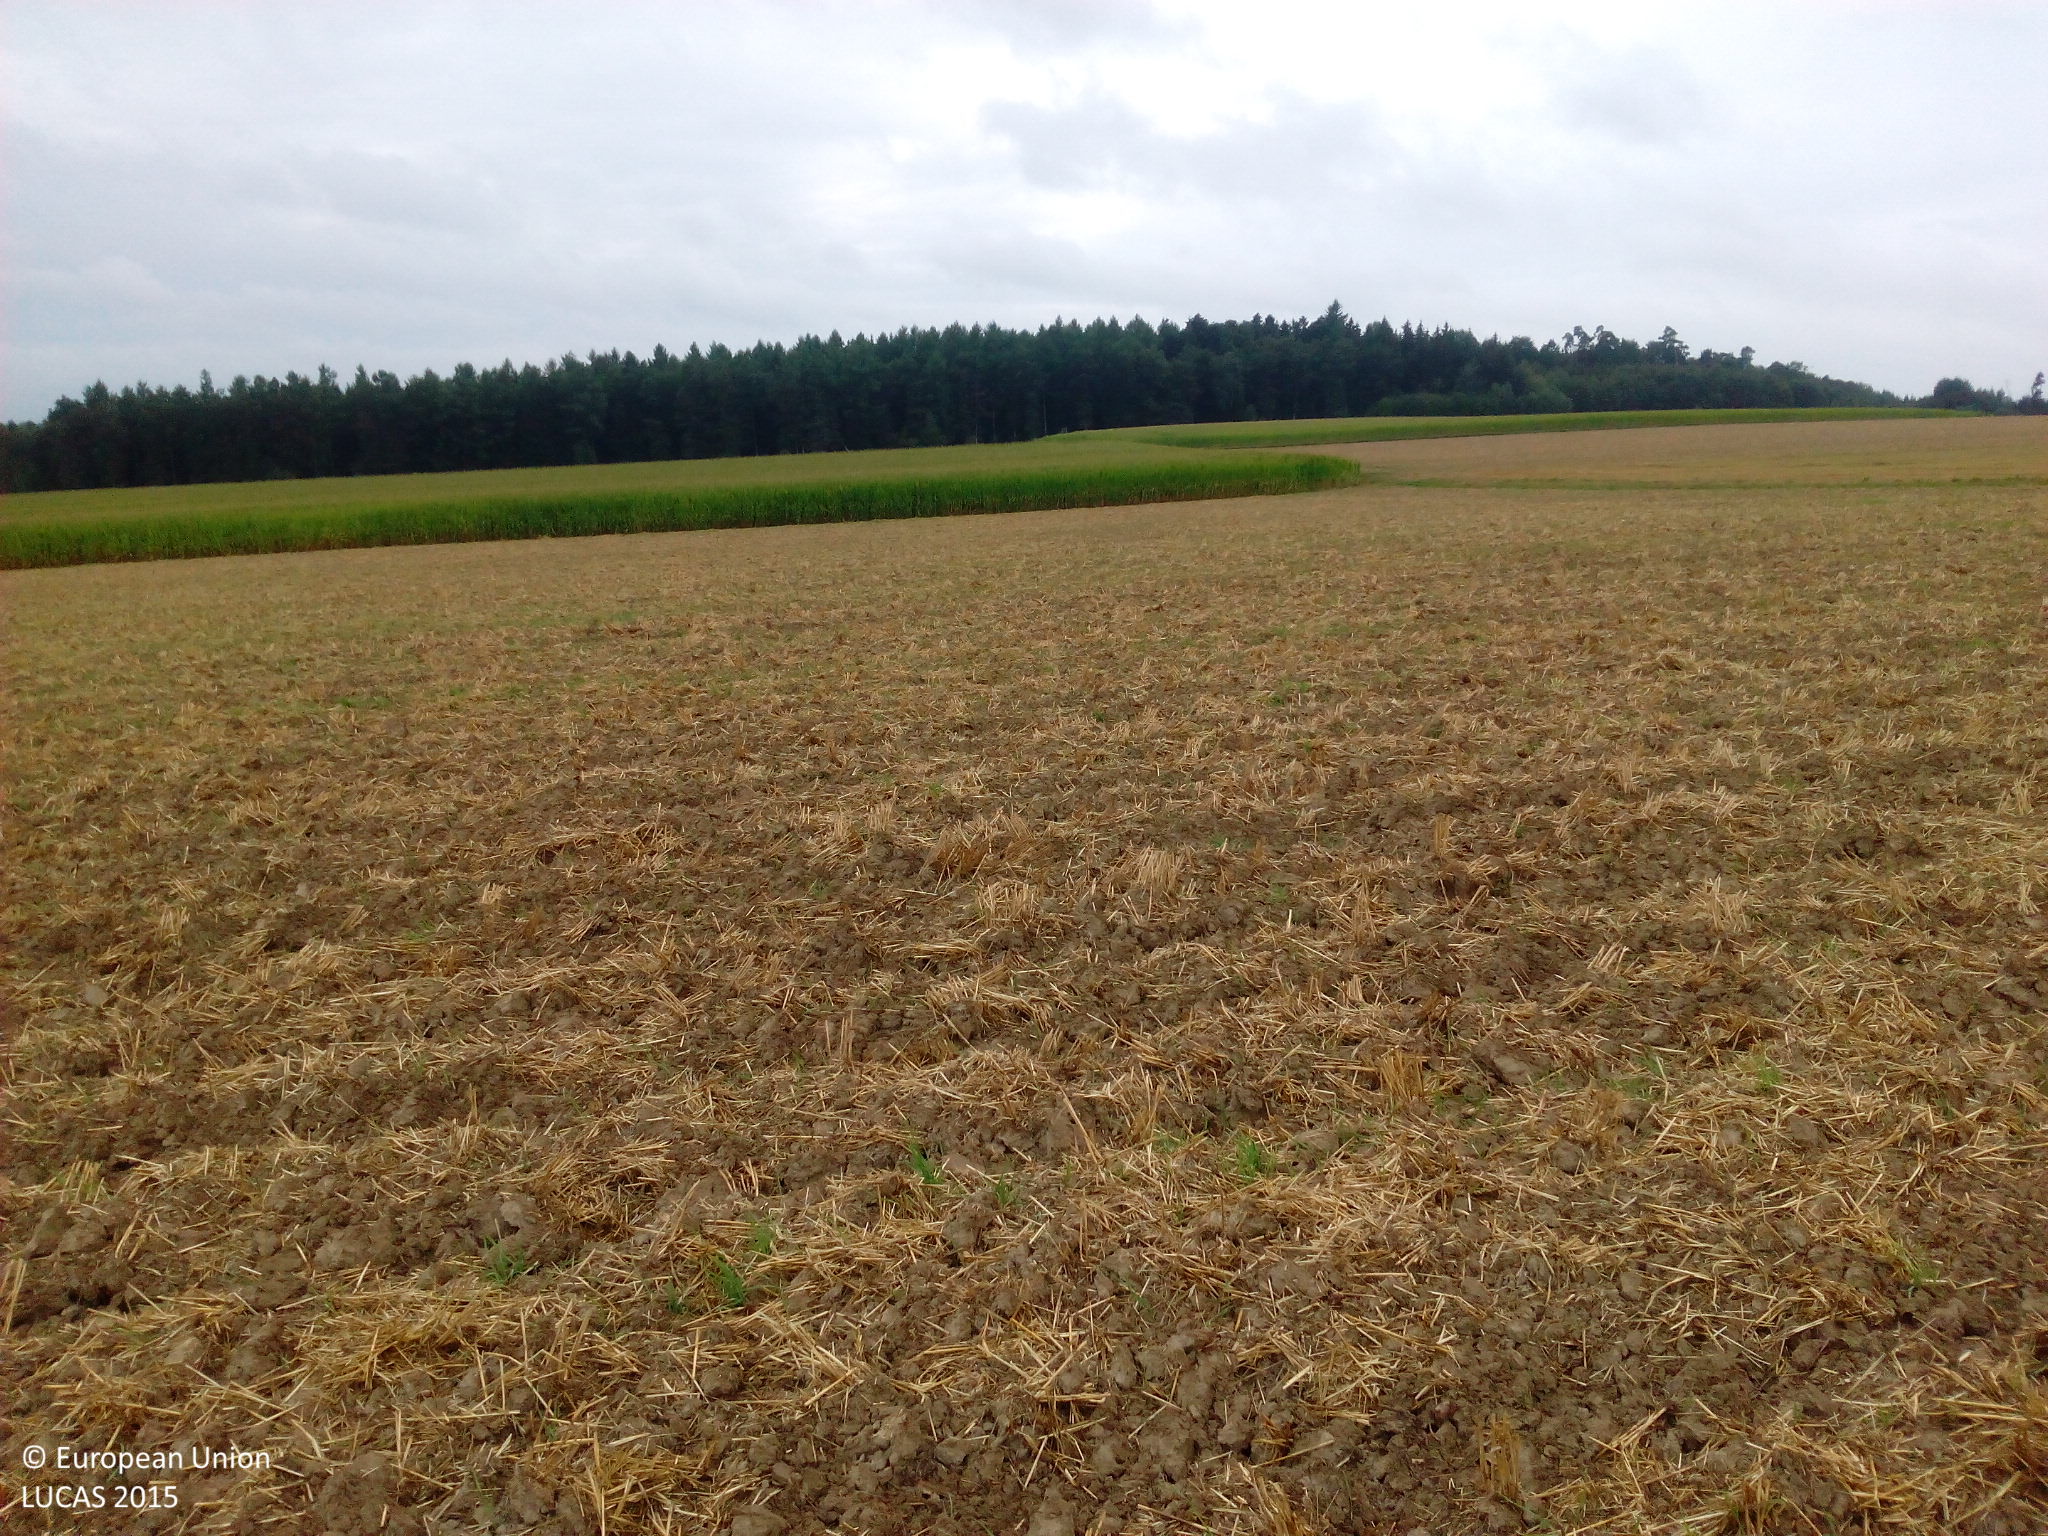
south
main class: Cropland
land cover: Common wheat
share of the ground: < 10 %
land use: Agriculture (excluding fallow land and kitchen gardens)
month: September
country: DE
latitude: 48.2952
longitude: 10.2560
